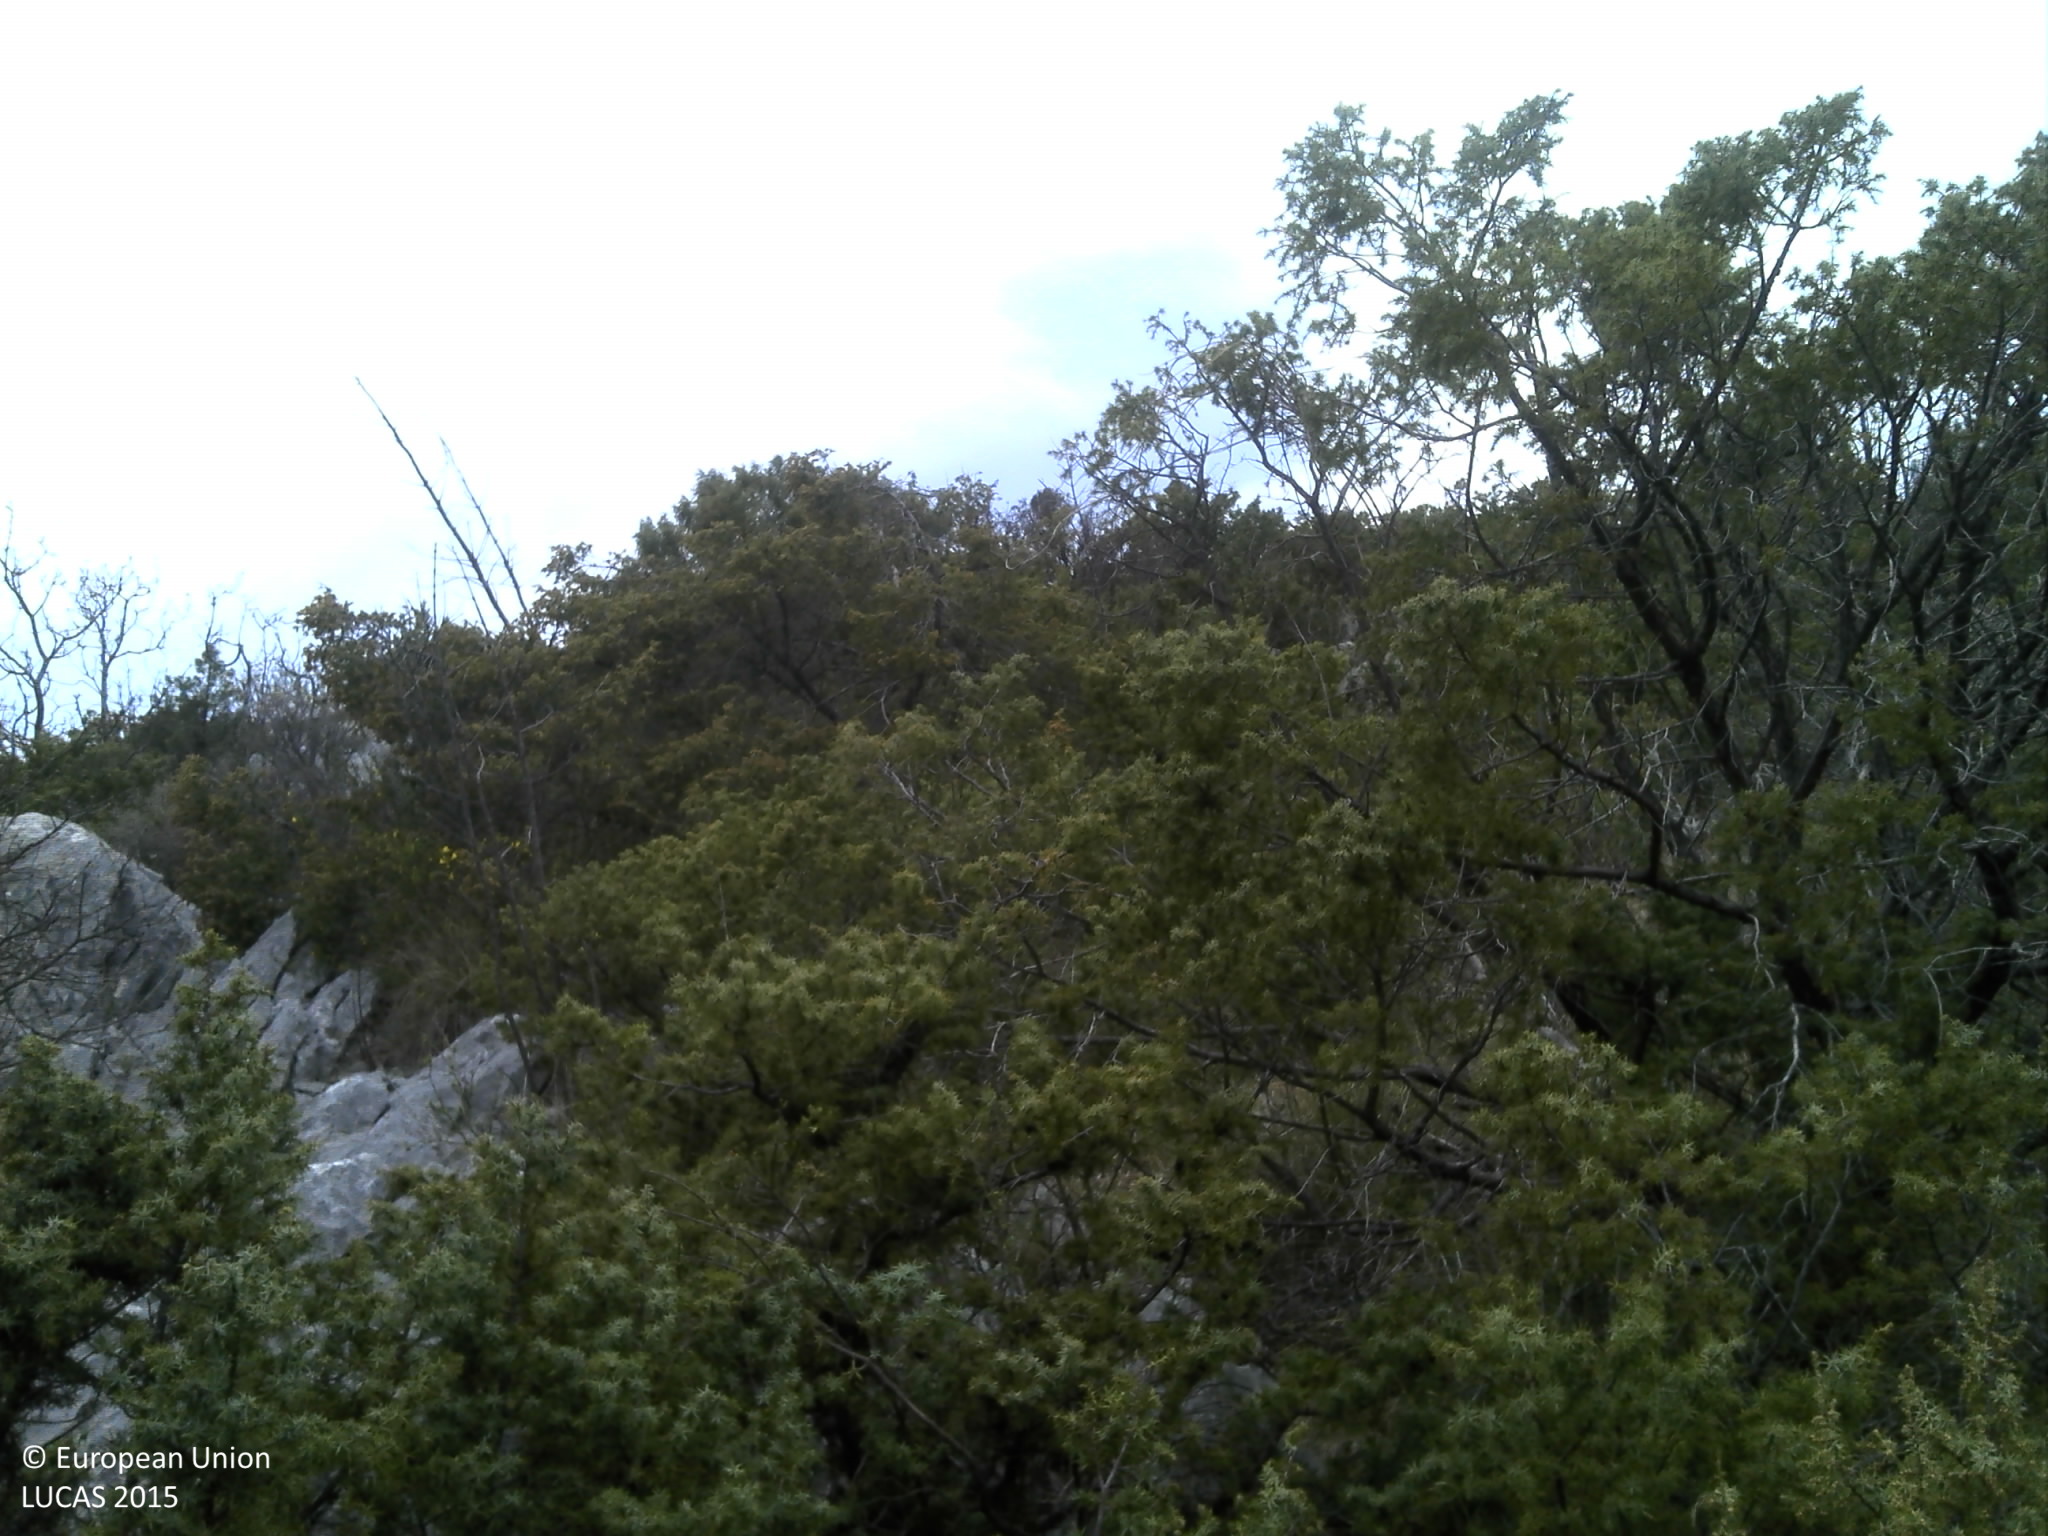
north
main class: Woodland
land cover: Other mixed woodland
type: coniferous forest of the mediterranean region
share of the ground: 50 - 75 %
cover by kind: coniferous forest trees 35 %, shrubs 25 %, broadleaved forest trees 15 %, consolidated bare surface 10 %, unconsolidated bare surface 10 %, herbaceous plants 5 %
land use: Semi-natural and natural areas not in use
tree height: < 5 m
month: April
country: HR
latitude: 43.6838
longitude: 16.0820
